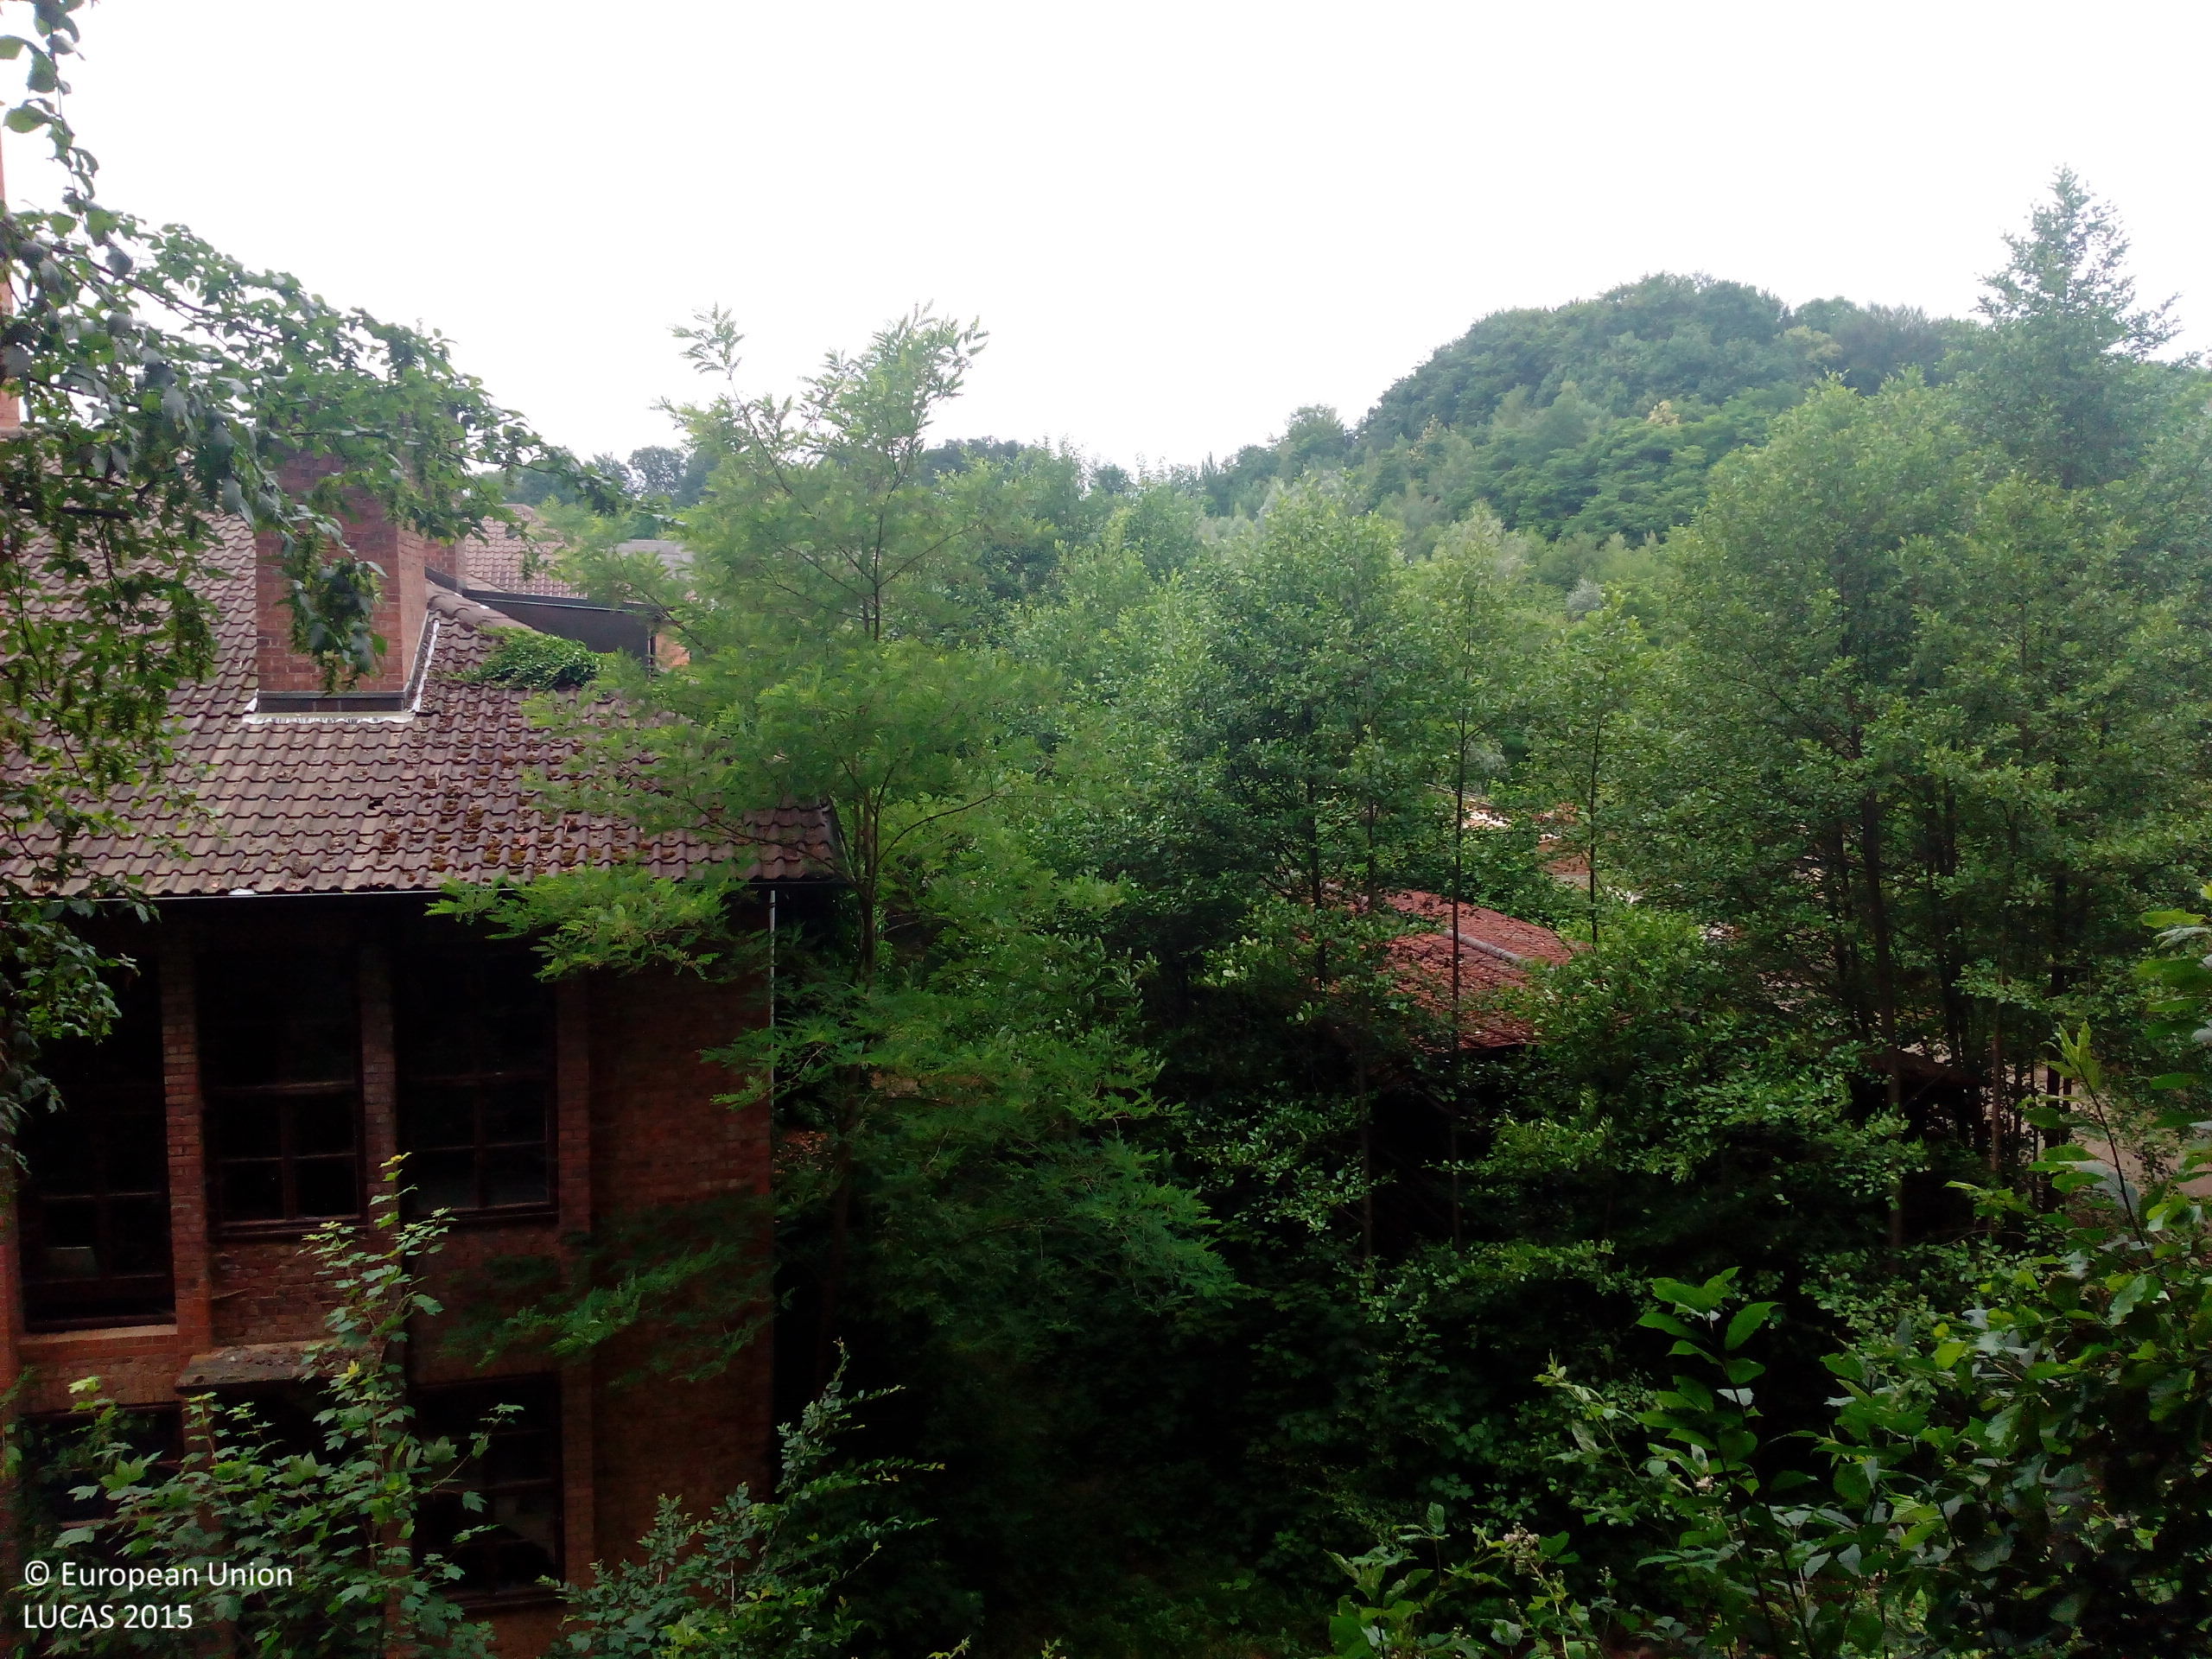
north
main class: Woodland
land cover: Broadleaved woodland
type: mesophytic deciduous forest
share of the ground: > 75 %
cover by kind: broadleaved forest trees 80 %, herbaceous plants 10 %, shrubs 5 %, consolidated bare surface 5 %
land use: Abandoned areas
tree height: > 5 m
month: June
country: DE
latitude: 48.6209
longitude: 8.0880
